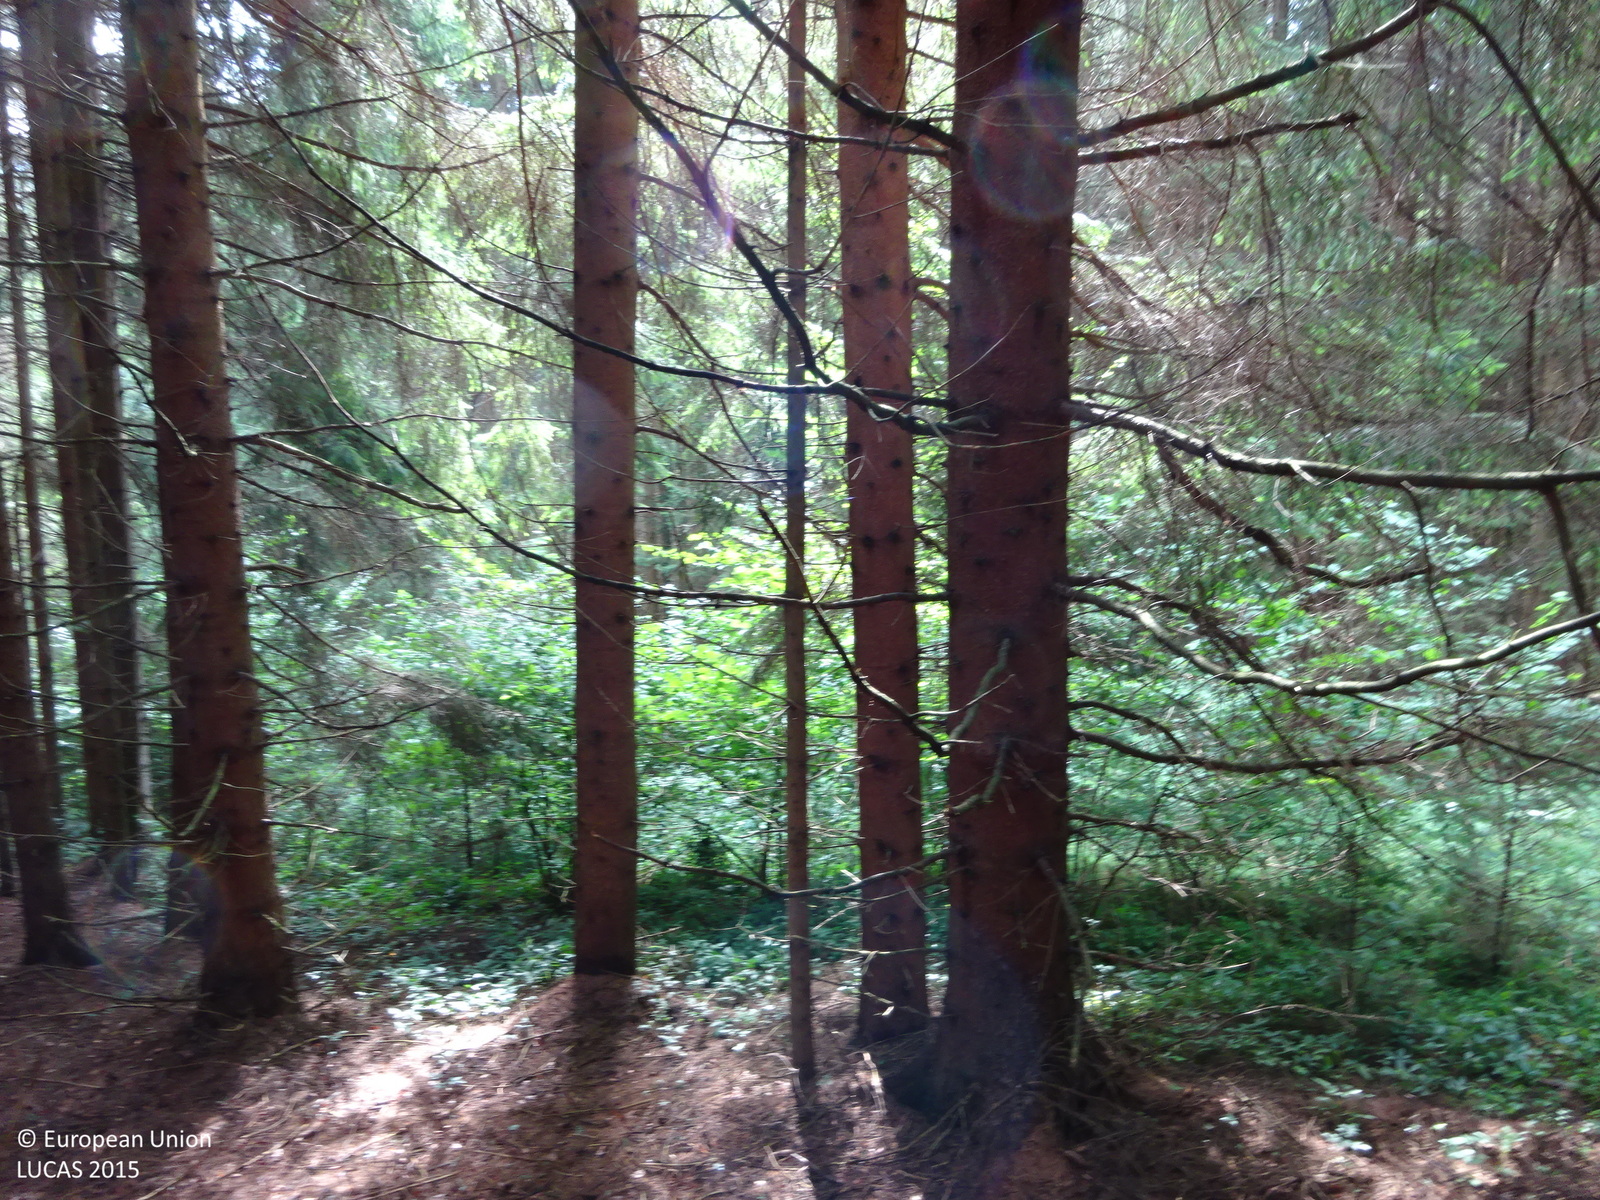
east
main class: Woodland
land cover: Spruce dominated coniferous woodland
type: alpine coniferous forest
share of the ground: > 75 %
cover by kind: coniferous forest trees 75 %, shrubs 20 %, broadleaved forest trees 5 %
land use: Forestry
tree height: > 5 m
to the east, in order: Spruce dominated coniferous woodland; Shrubland with sparse tree cover; Electric lines; Shrubland with sparse tree cover; Spruce dominated coniferous woodland; Tracks; Spruce dominated coniferous woodland; Tracks; Spruce dominated coniferous woodland; Rivers and streams; Shrubland with sparse tree cover; Tracks; Spruce dominated mixed woodland; Tracks; Spruce dominated mixed woodland; Tracks; Spruce dominated coniferous woodland
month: July
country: AT
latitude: 47.2214
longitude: 15.4806
